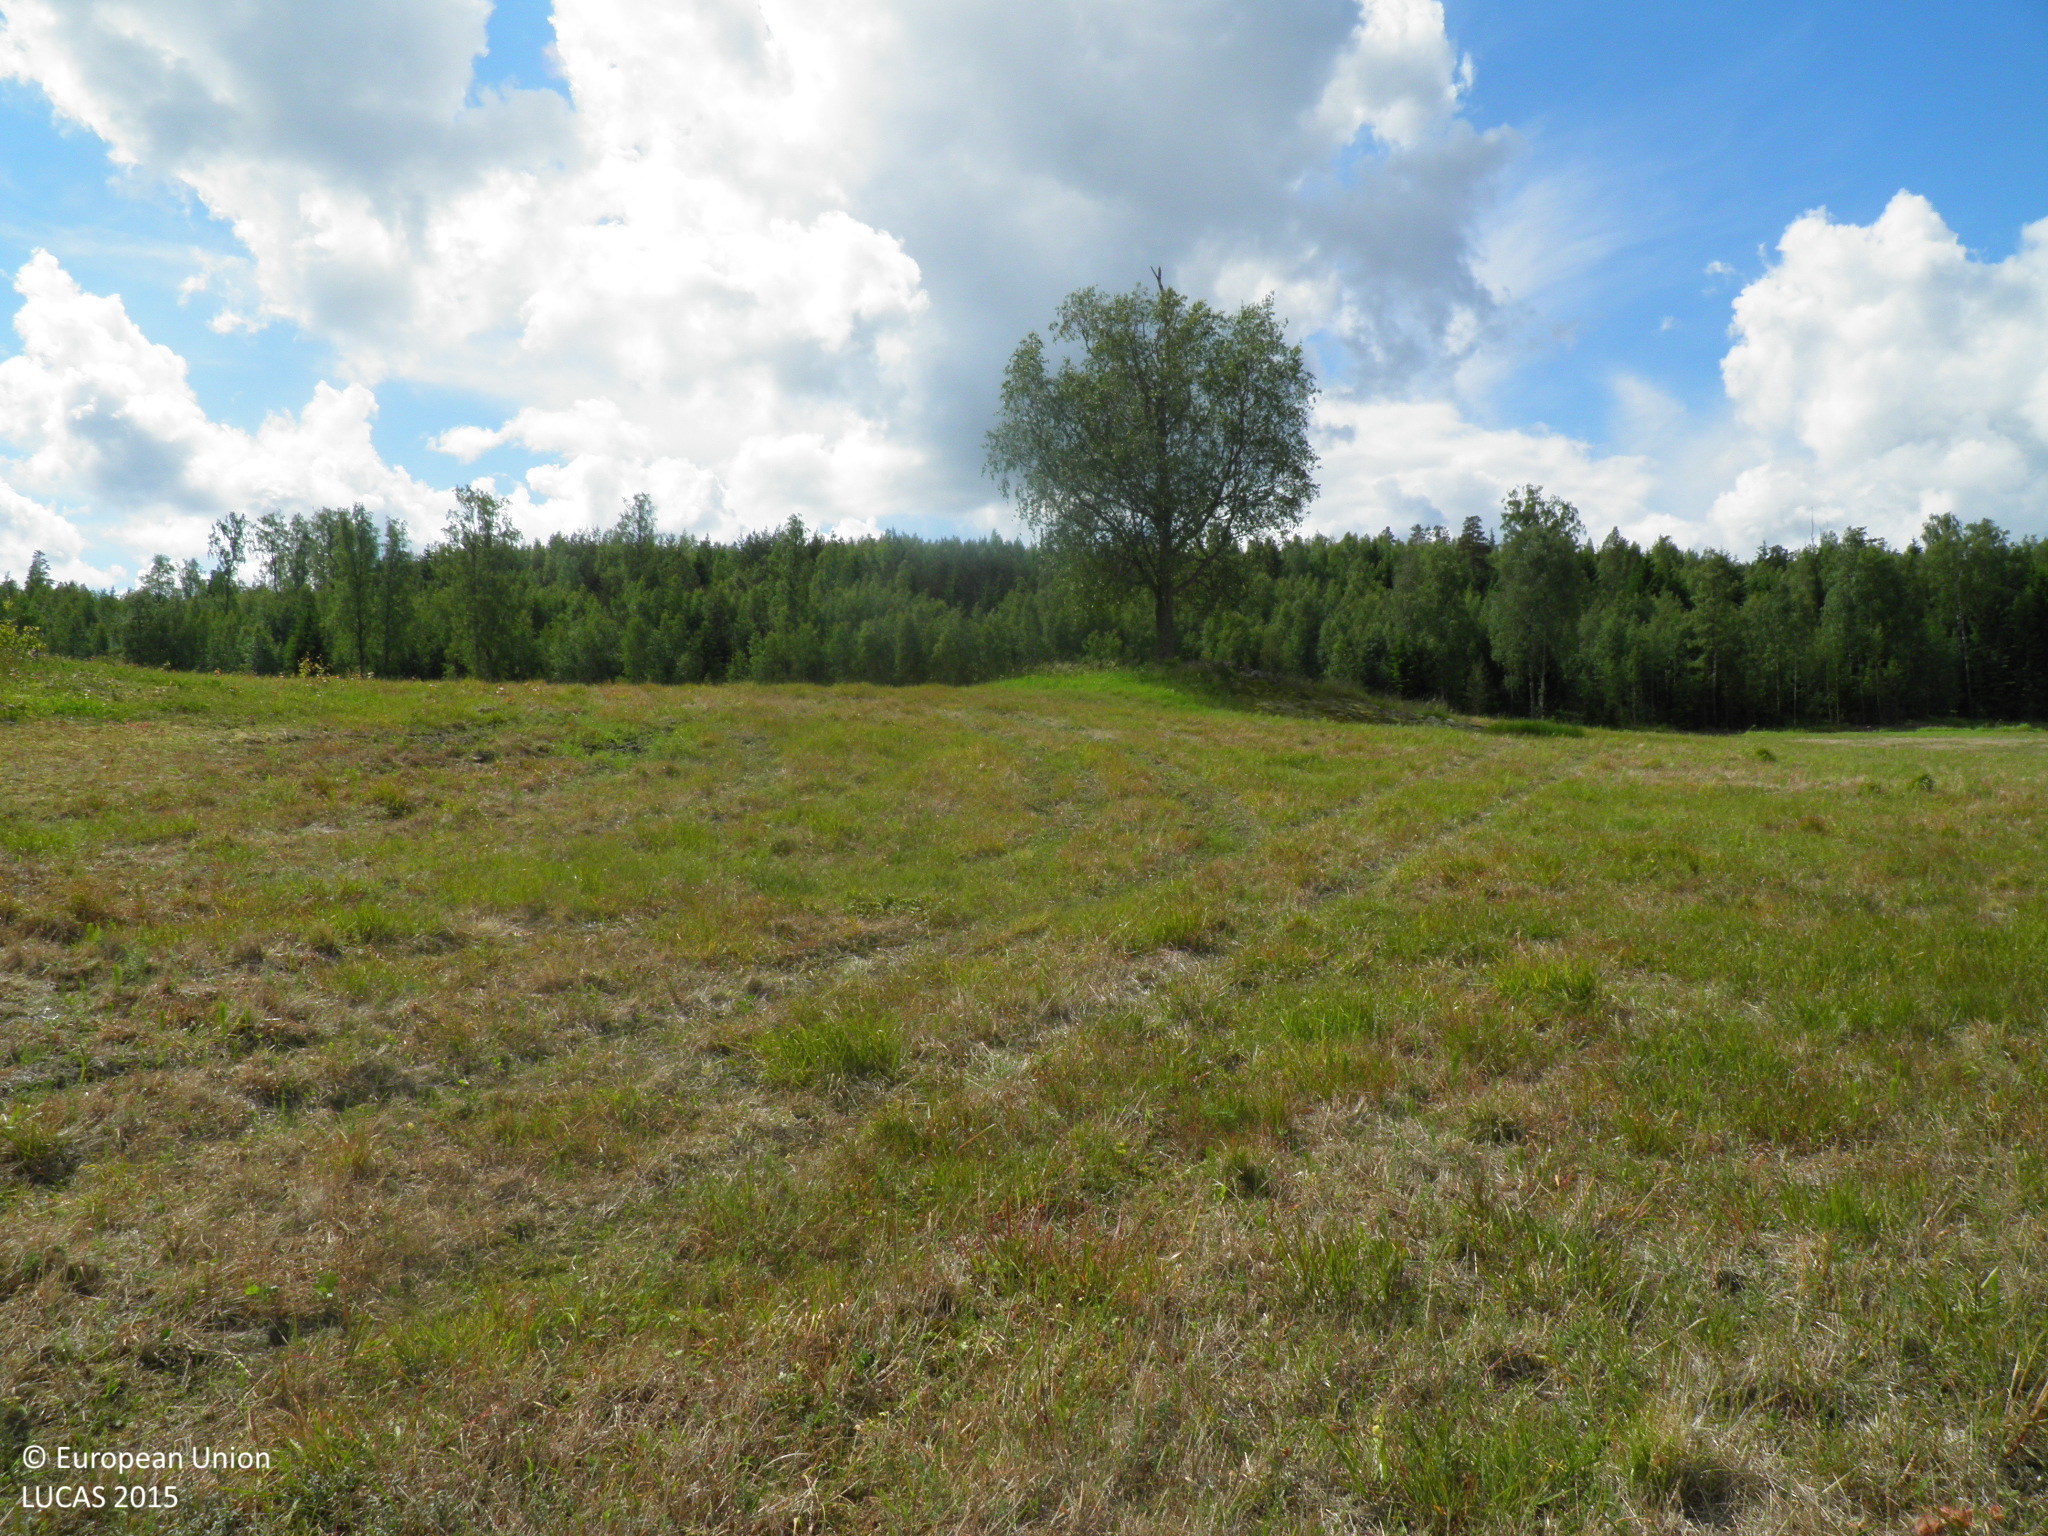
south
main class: Grassland
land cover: Spontaneously vegetated surfaces
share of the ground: > 75 %
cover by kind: herbaceous plants 90 %, unconsolidated bare surface 10 %
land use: Fallow land
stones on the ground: < 10 %
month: June
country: FI
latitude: 60.2943
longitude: 22.5368
